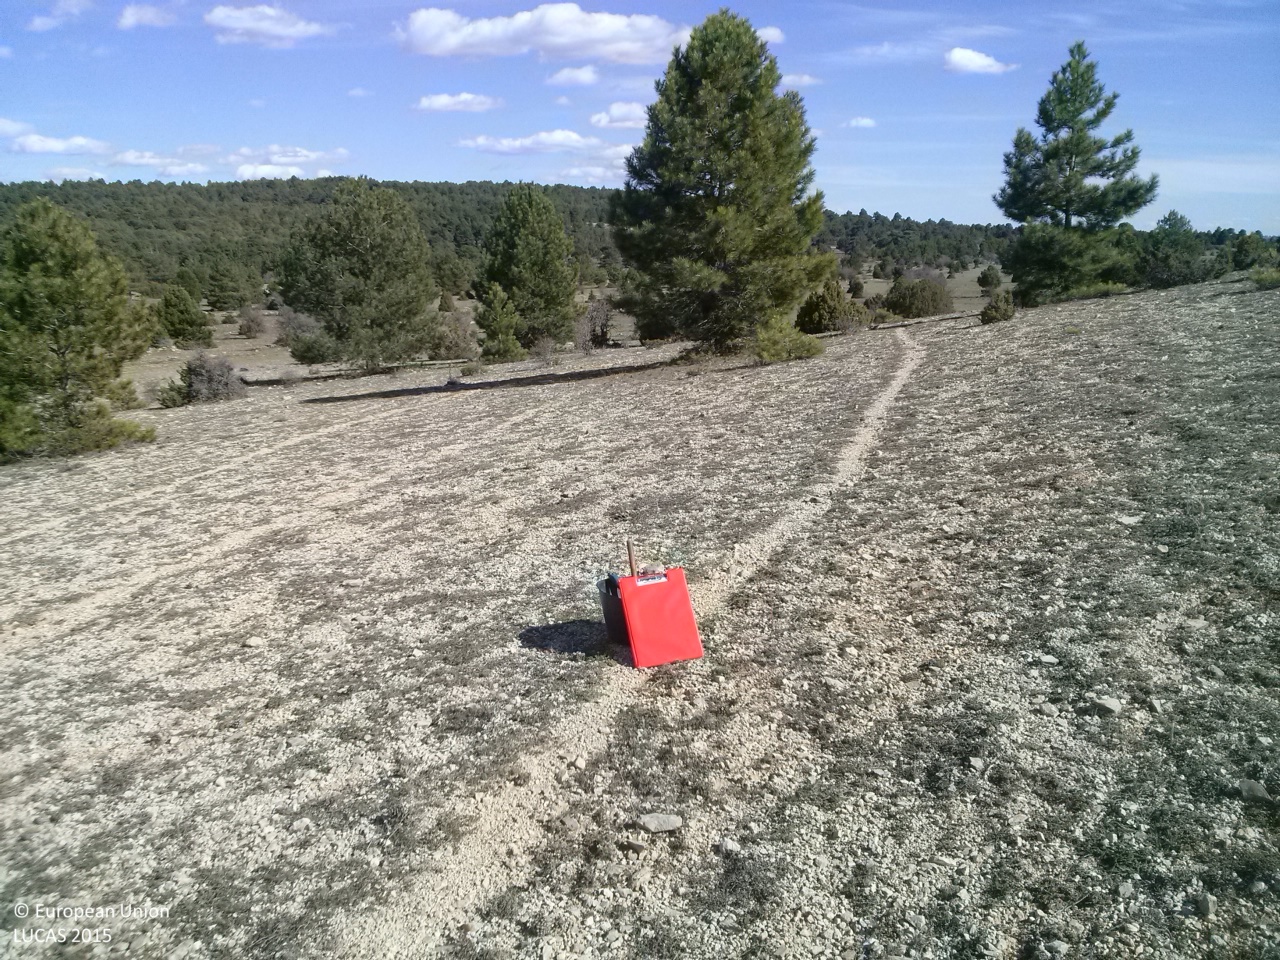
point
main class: Grassland
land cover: Grassland without tree/shrub cover
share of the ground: 25 - 50 %
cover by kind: unconsolidated bare surface 55 %, herbaceous plants 40 %, shrubs 5 %
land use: Agriculture (excluding fallow land and kitchen gardens)
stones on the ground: 25 - 50 %
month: April
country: ES
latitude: 40.1689
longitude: -1.8388
